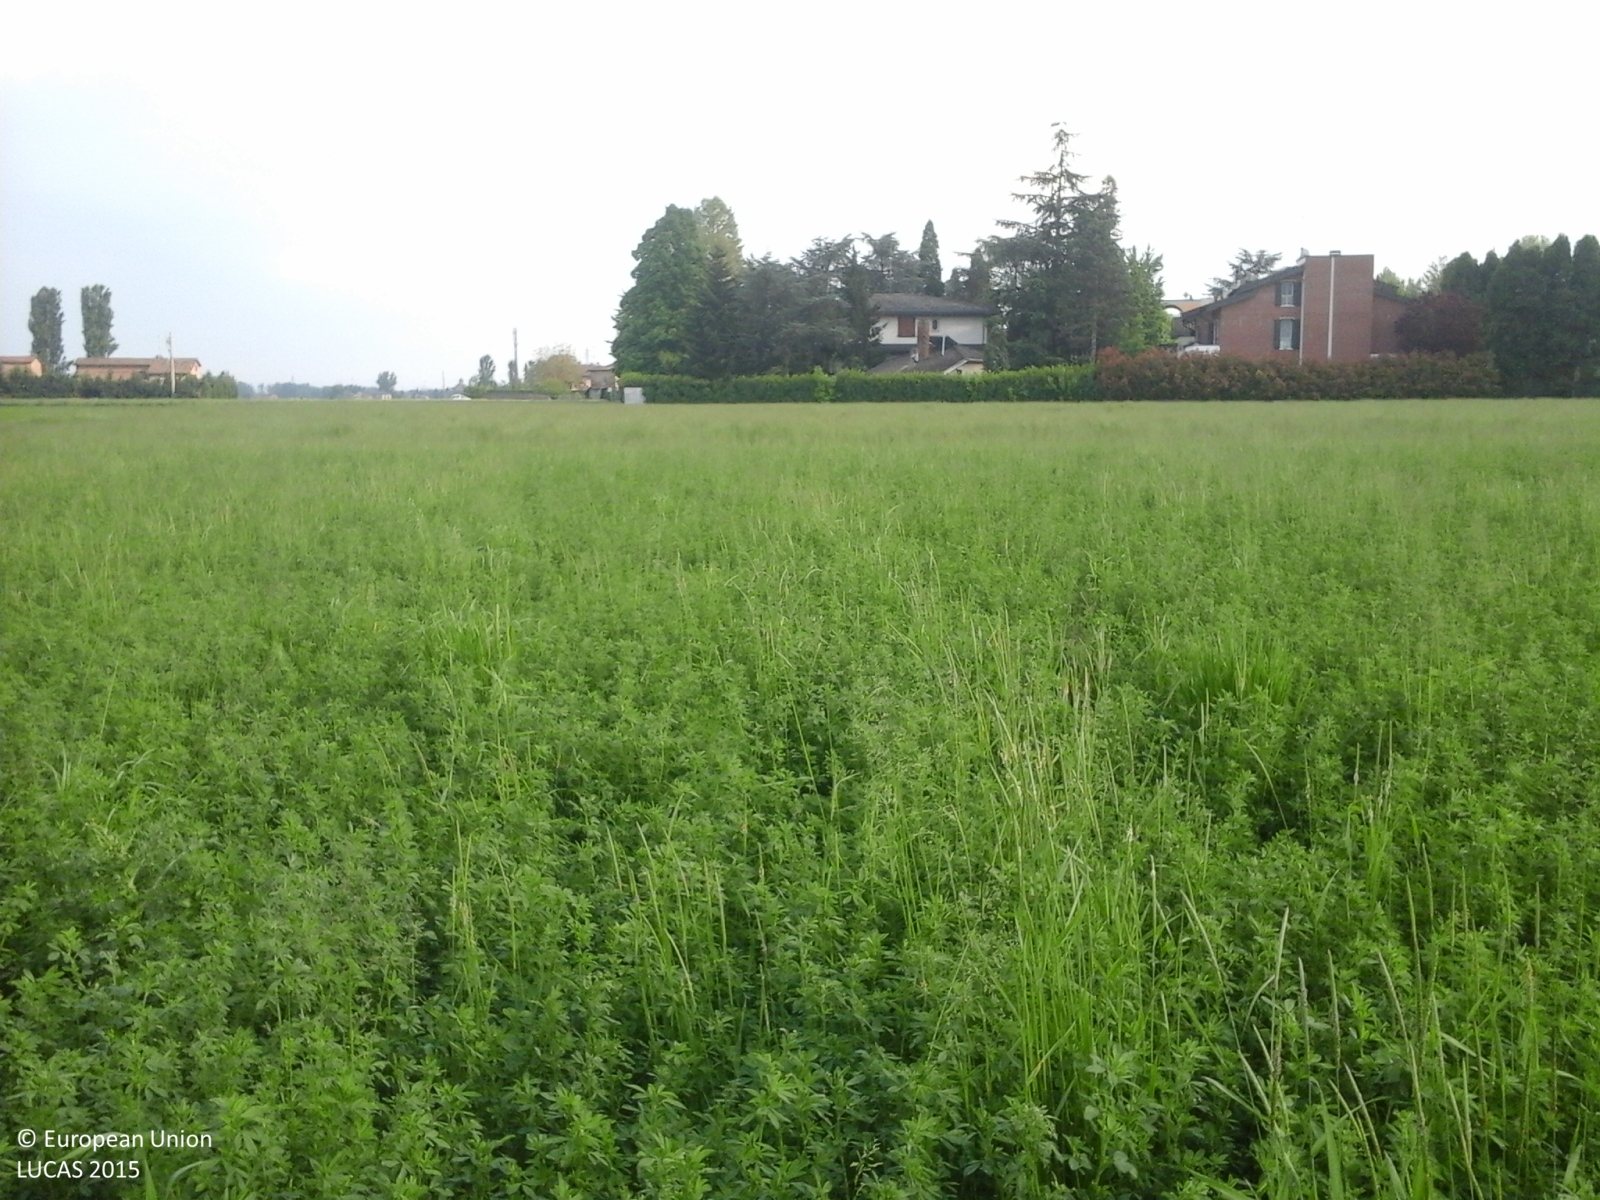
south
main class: Cropland
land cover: Lucerne
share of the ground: > 75 %
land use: Agriculture (excluding fallow land and kitchen gardens)
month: April
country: IT
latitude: 44.6894
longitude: 10.8940
